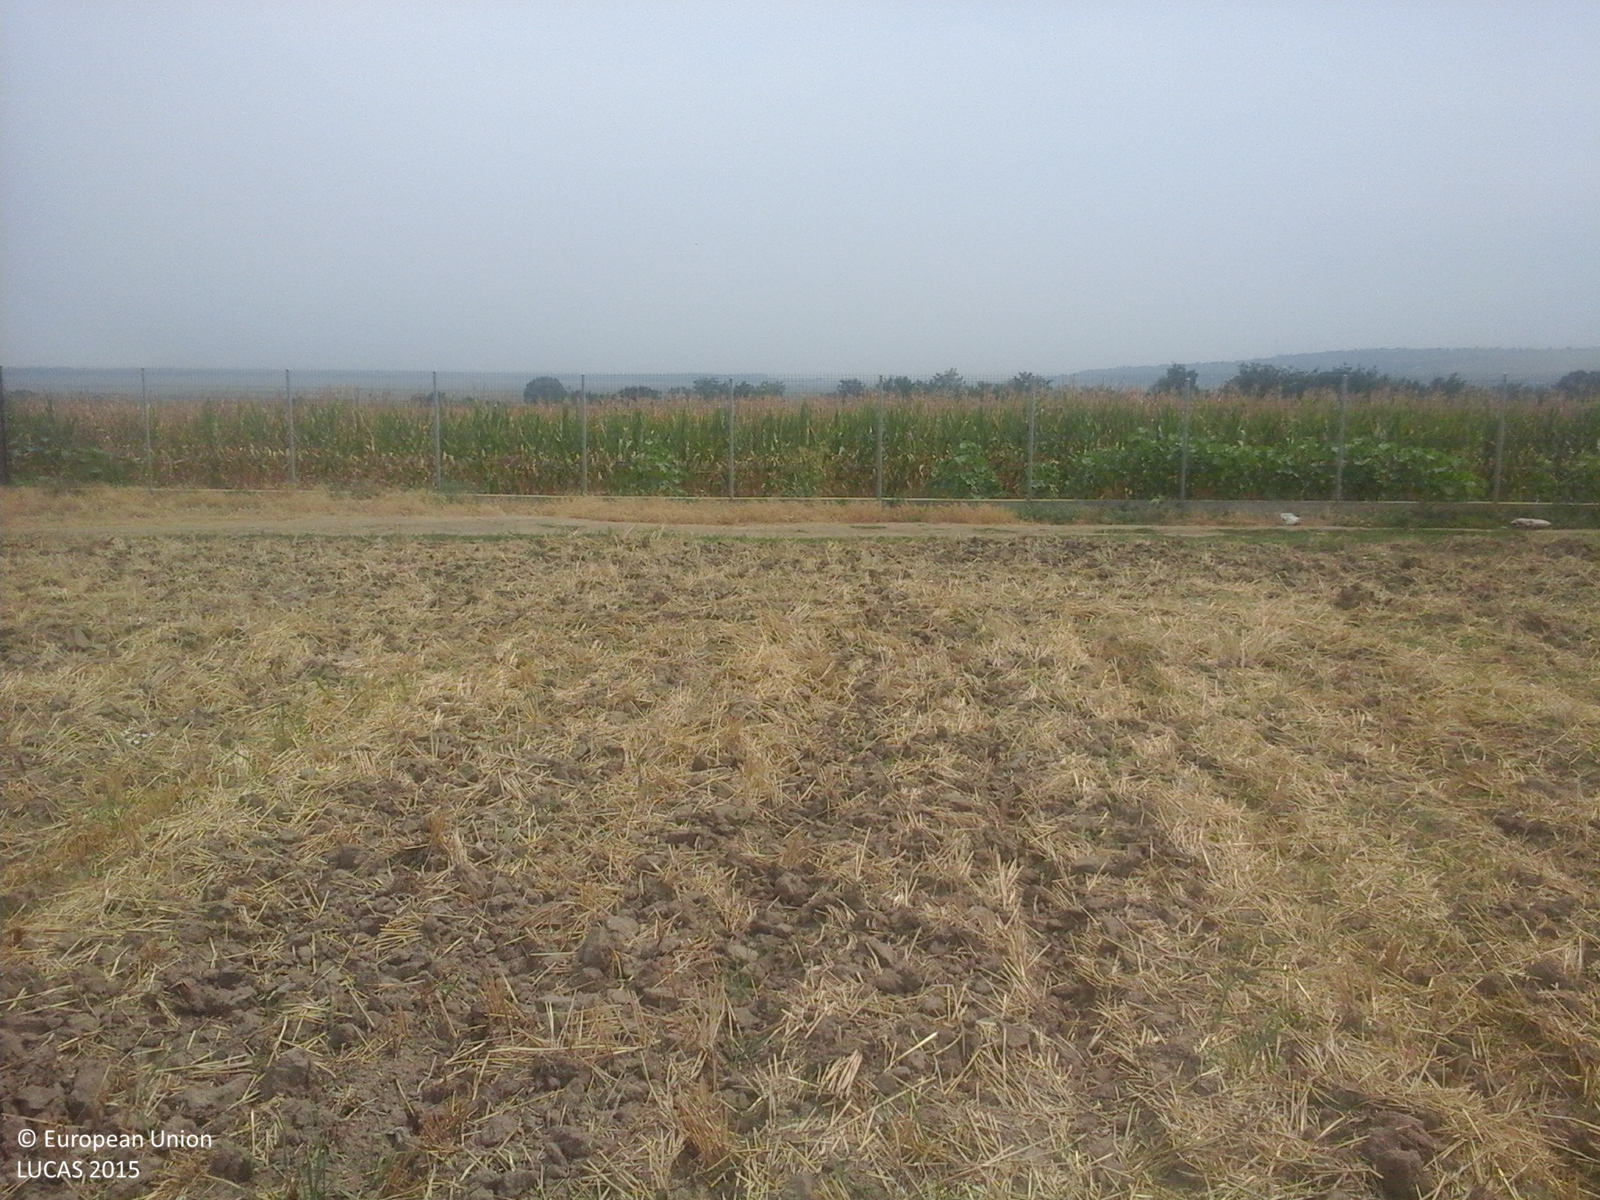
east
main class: Cropland
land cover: Durum wheat
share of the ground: 10 - 25 %
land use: Agriculture (excluding fallow land and kitchen gardens)
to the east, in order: Durum wheat; Tracks; Grass margins; Fences; Maize; Artificial constructions in urban areas
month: July
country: RO
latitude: 45.2953
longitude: 28.2698
